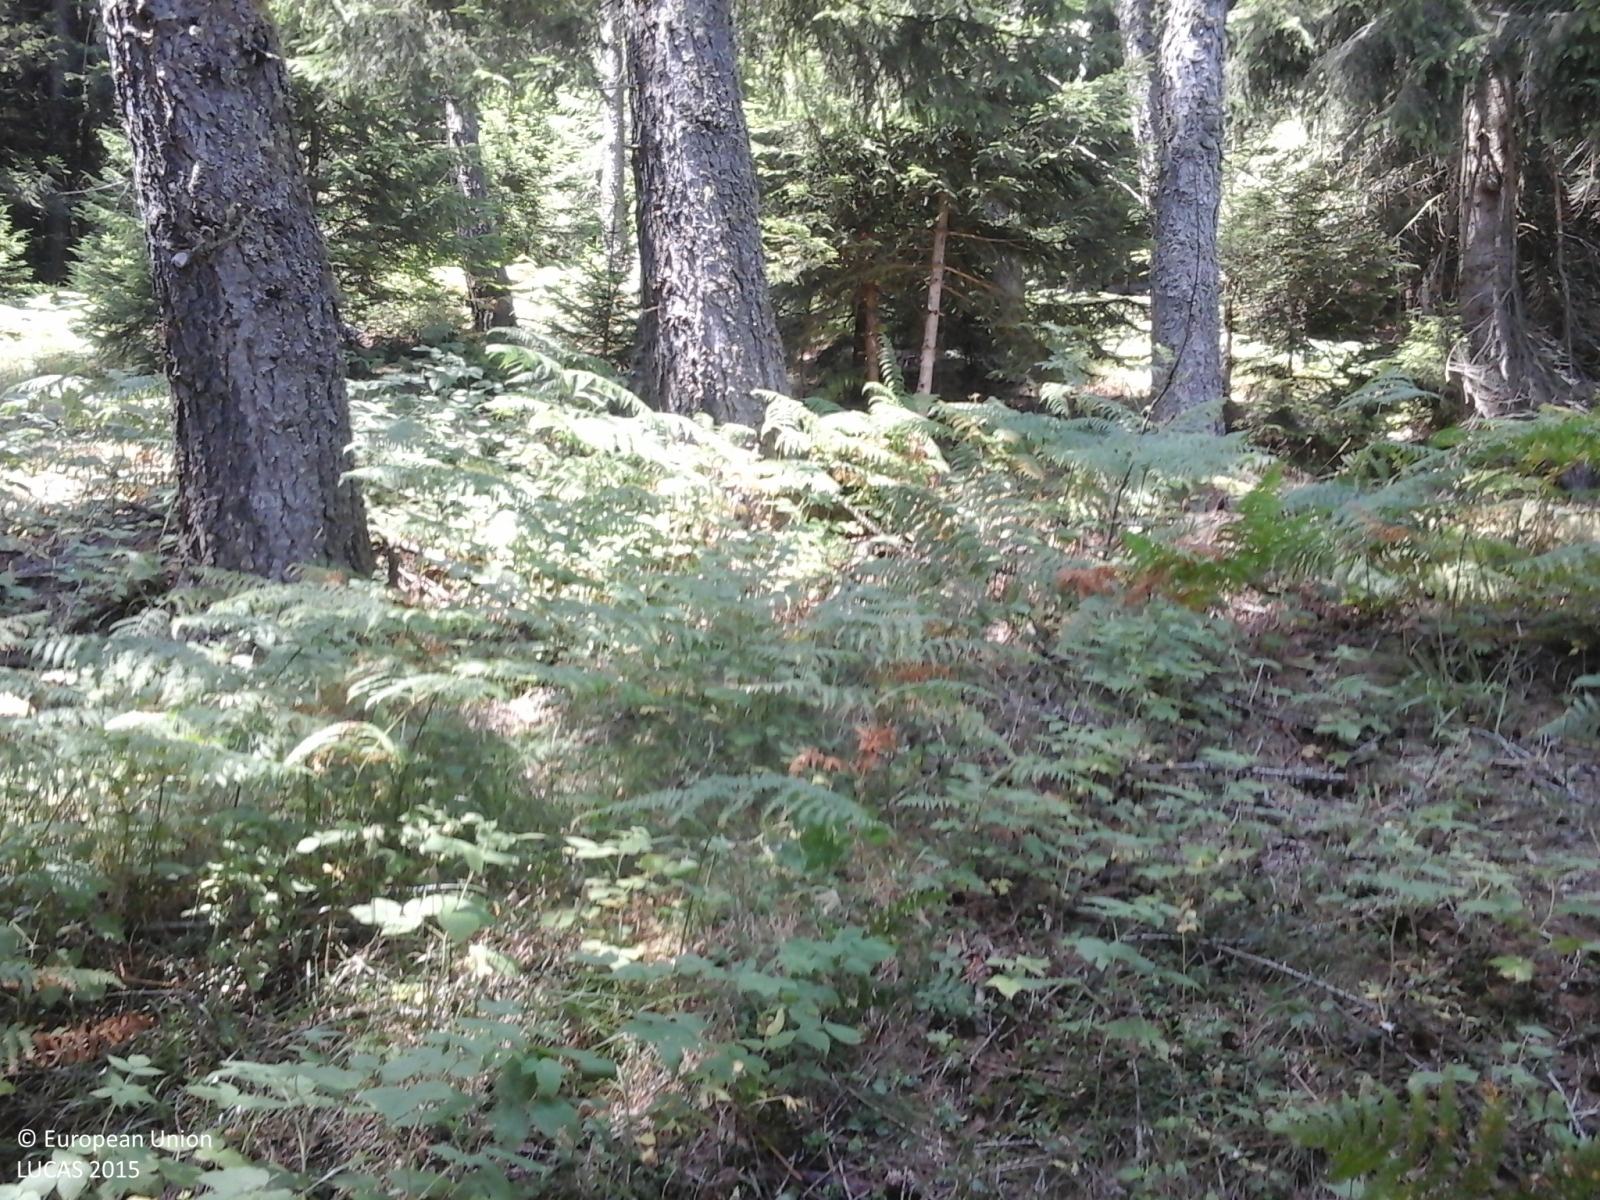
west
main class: Woodland
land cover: Spruce dominated coniferous woodland
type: alpine coniferous forest
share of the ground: > 75 %
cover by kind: coniferous forest trees 100 %
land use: Agriculture (excluding fallow land and kitchen gardens)
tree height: > 5 m
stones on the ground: < 10 %
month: July
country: IT
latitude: 46.1891
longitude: 10.0647
